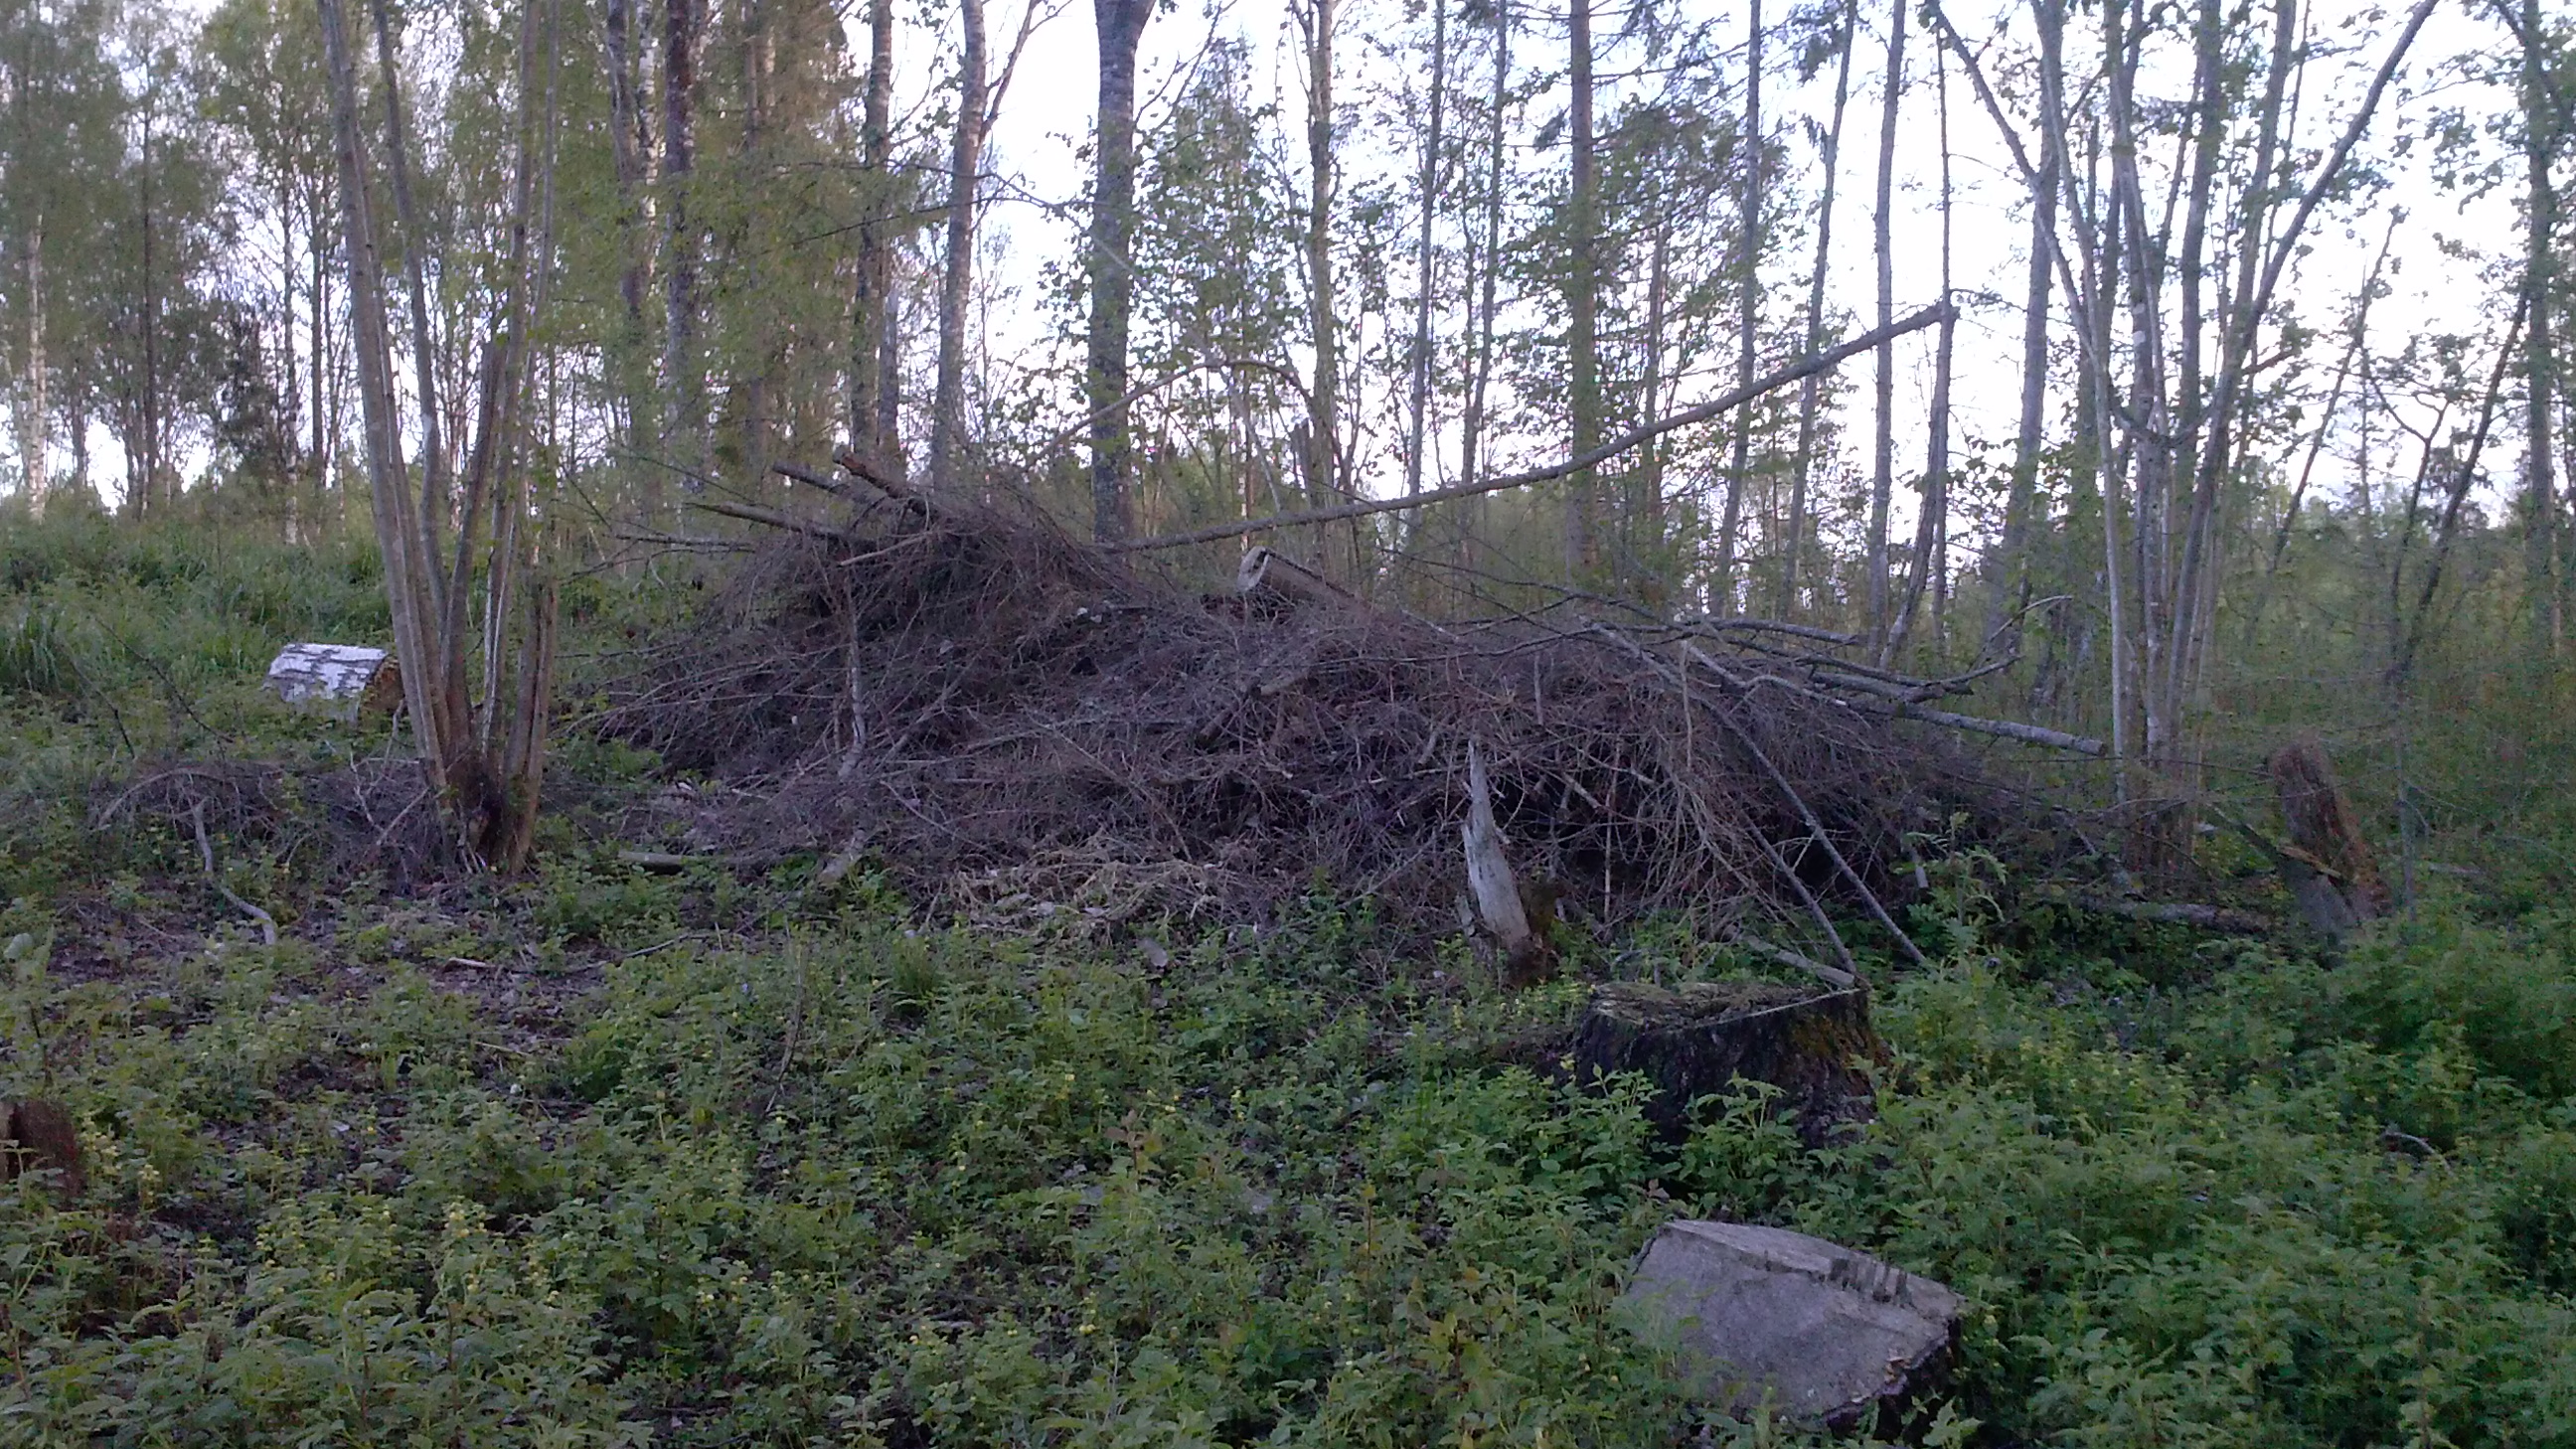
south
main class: Woodland
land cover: Broadleaved woodland
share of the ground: 50 - 75 %
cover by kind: broadleaved forest trees 50 %, shrubs 50 %
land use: Forestry
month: May
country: LV
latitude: 56.0707
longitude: 27.8143
